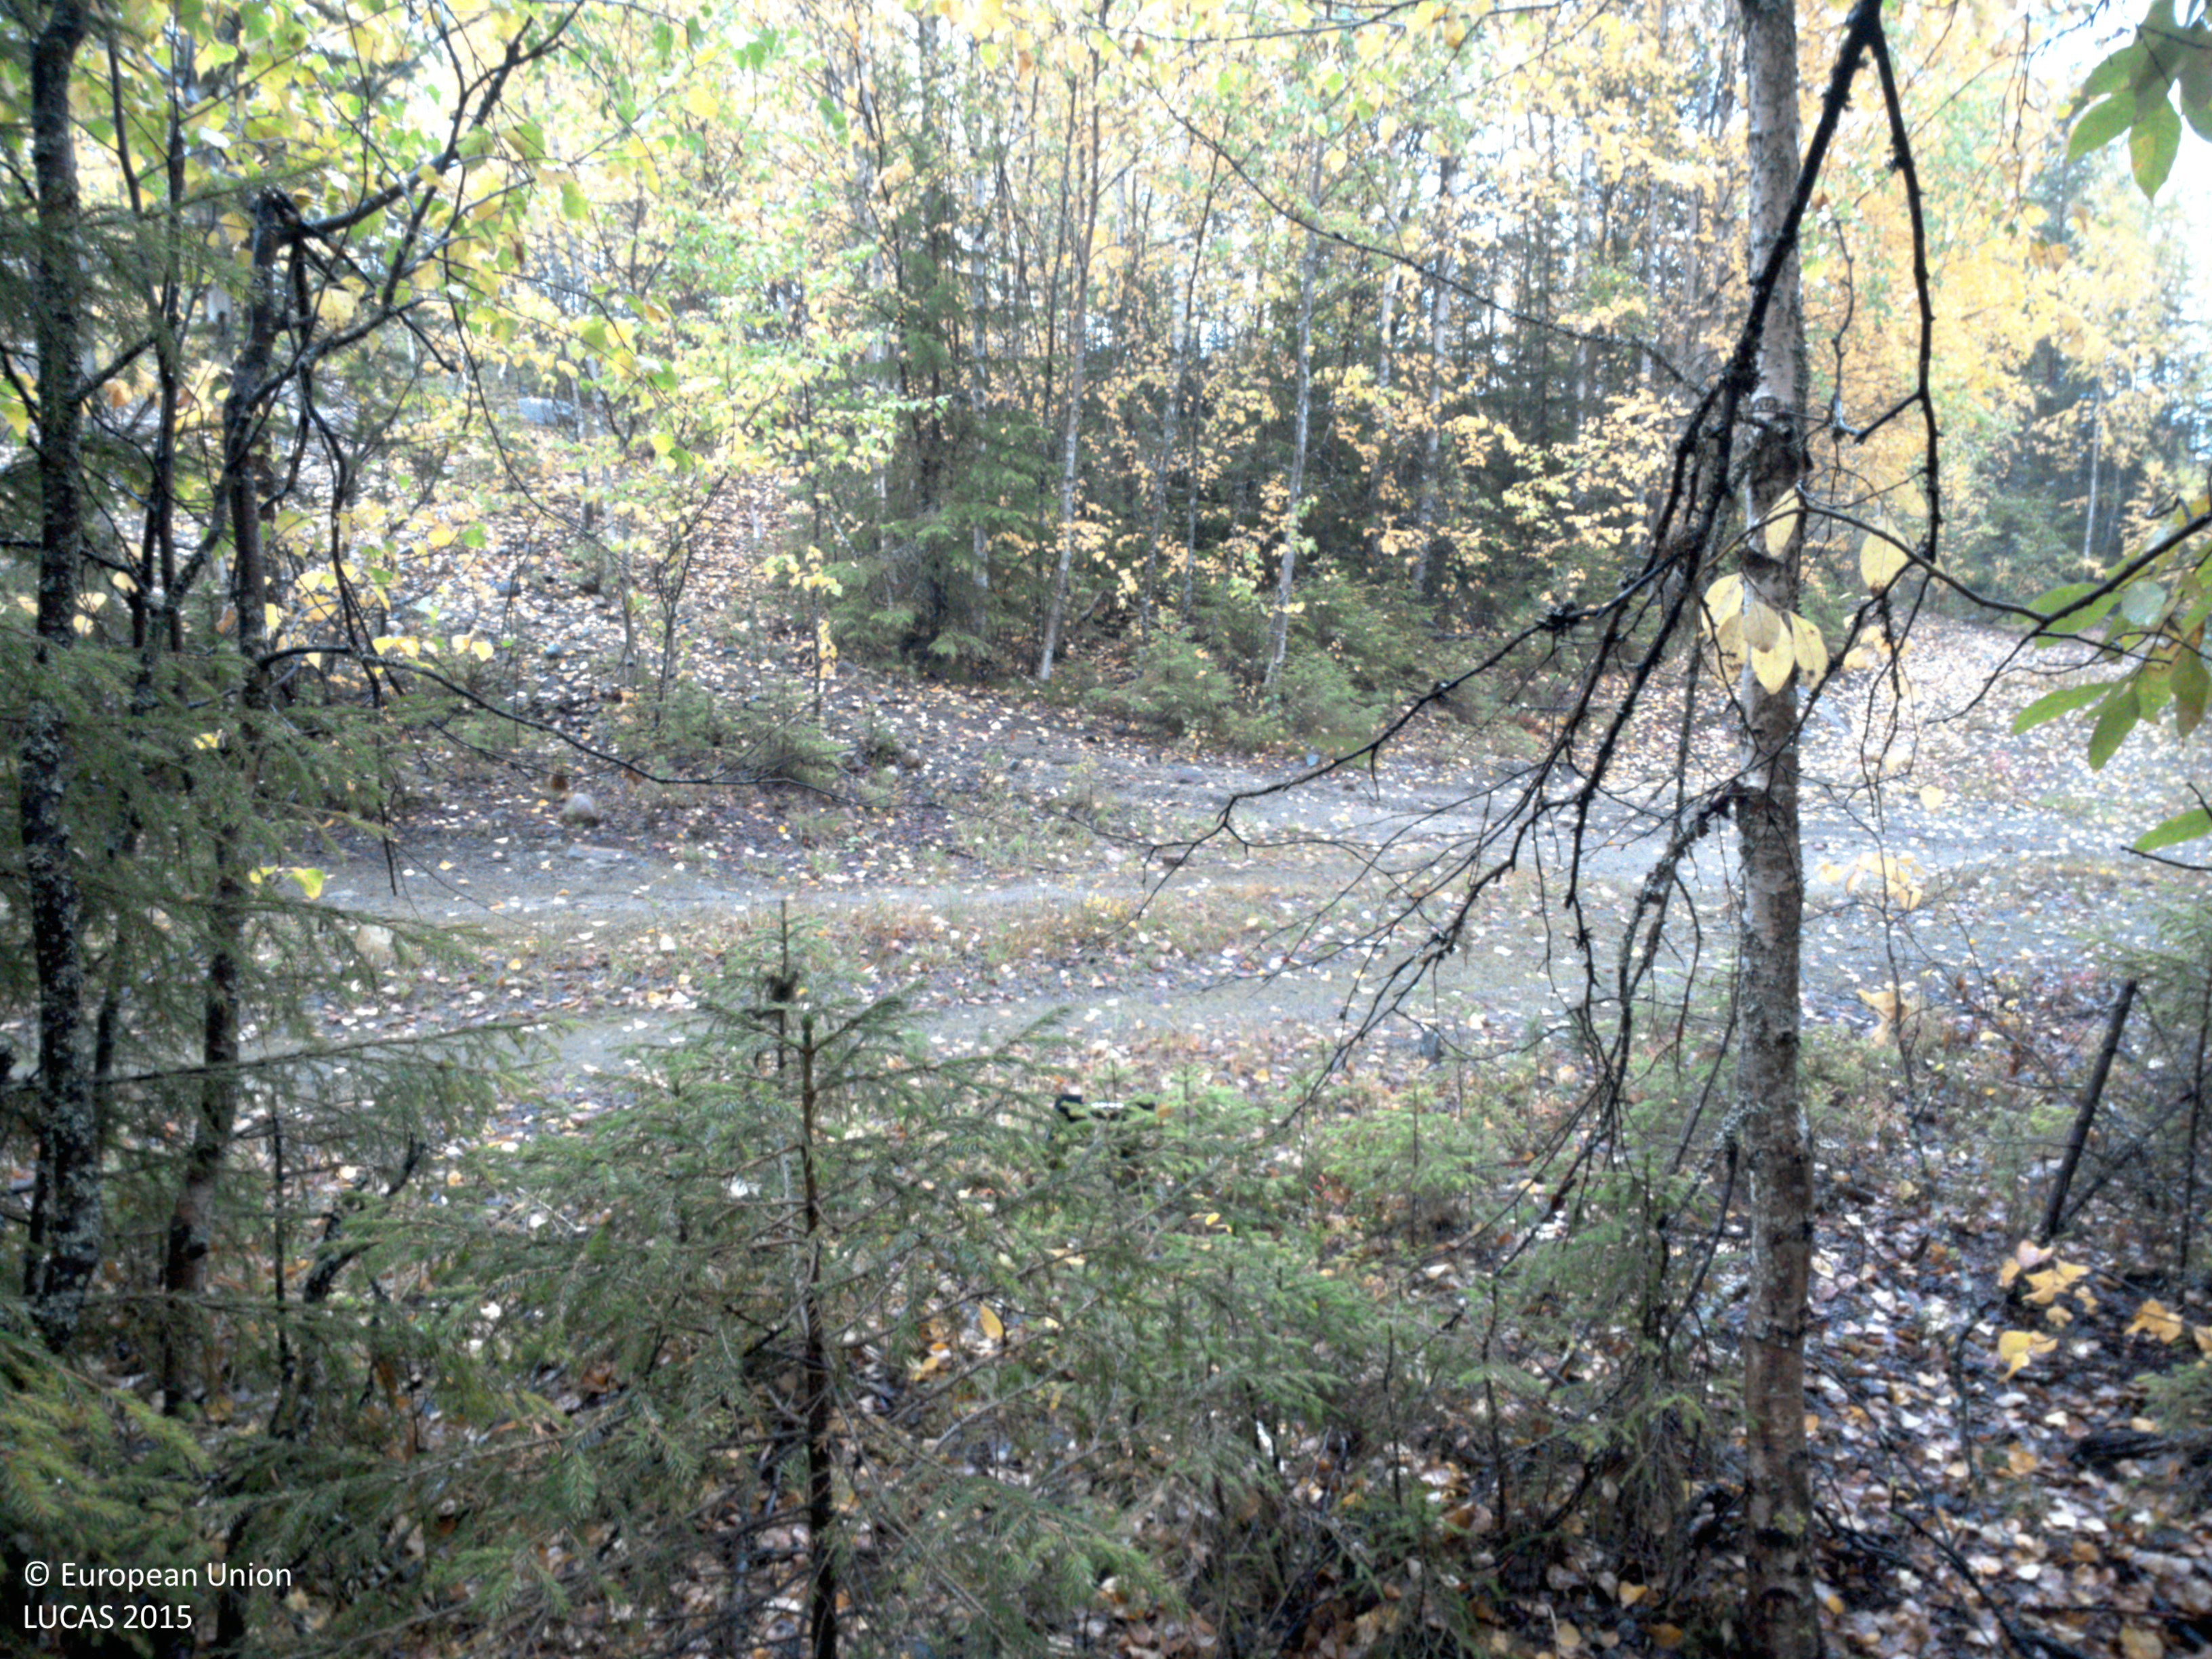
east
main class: Woodland
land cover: Spruce dominated mixed woodland
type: hemiboreal forest and nemoral coniferous forest and mixed broadleaved-coniferous forest
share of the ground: > 75 %
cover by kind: coniferous forest trees 60 %, broadleaved forest trees 20 %, shrubs 10 %, unconsolidated bare surface 10 %
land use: Forestry
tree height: > 5 m
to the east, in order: Spruce dominated mixed woodland; Tracks; Spruce dominated coniferous woodland; Pine dominated mixed woodland; Tracks; Other mixed woodland; Tracks; Pine dominated mixed woodland; Pine dominated coniferous woodland
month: September
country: SE
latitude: 64.9395
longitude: 19.3829
